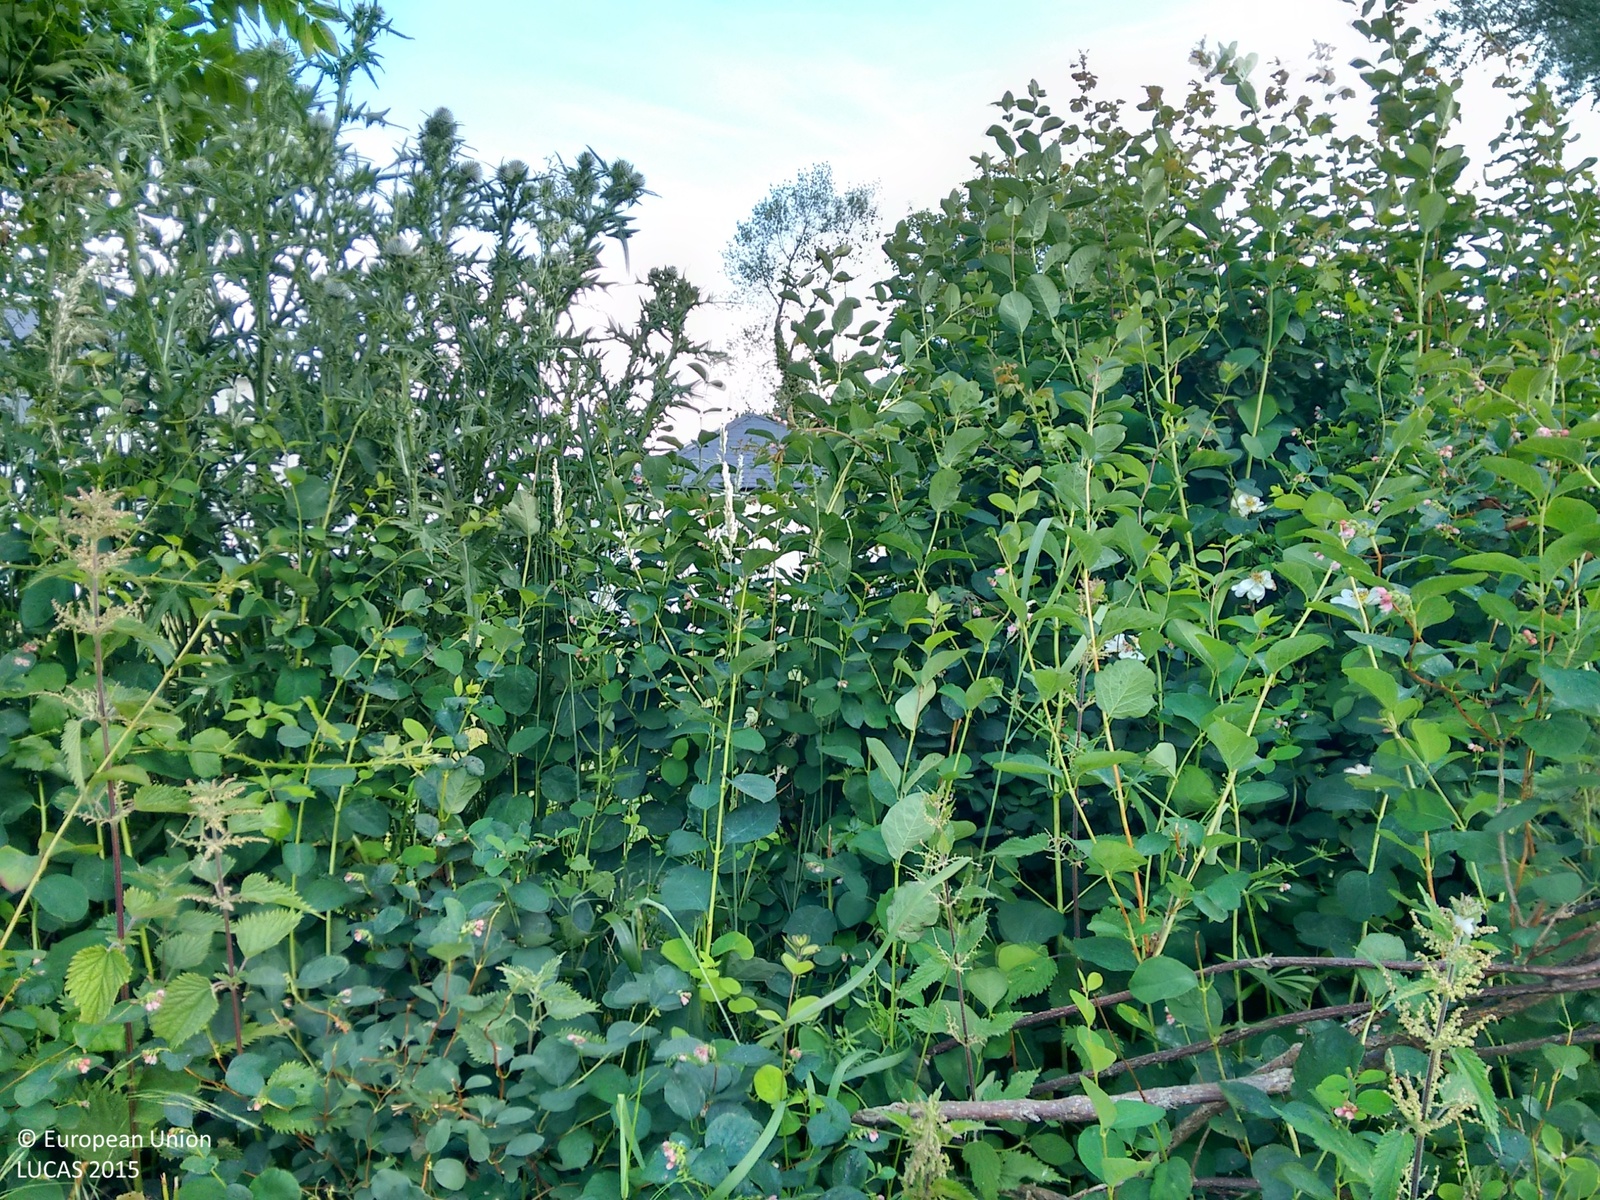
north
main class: Grassland
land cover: Grassland with sparse tree/shrub cover
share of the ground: > 75 %
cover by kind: herbaceous plants 95 %, broadleaved forest trees 5 %
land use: Residential
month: July
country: IE
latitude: 52.5218
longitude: -7.5974
